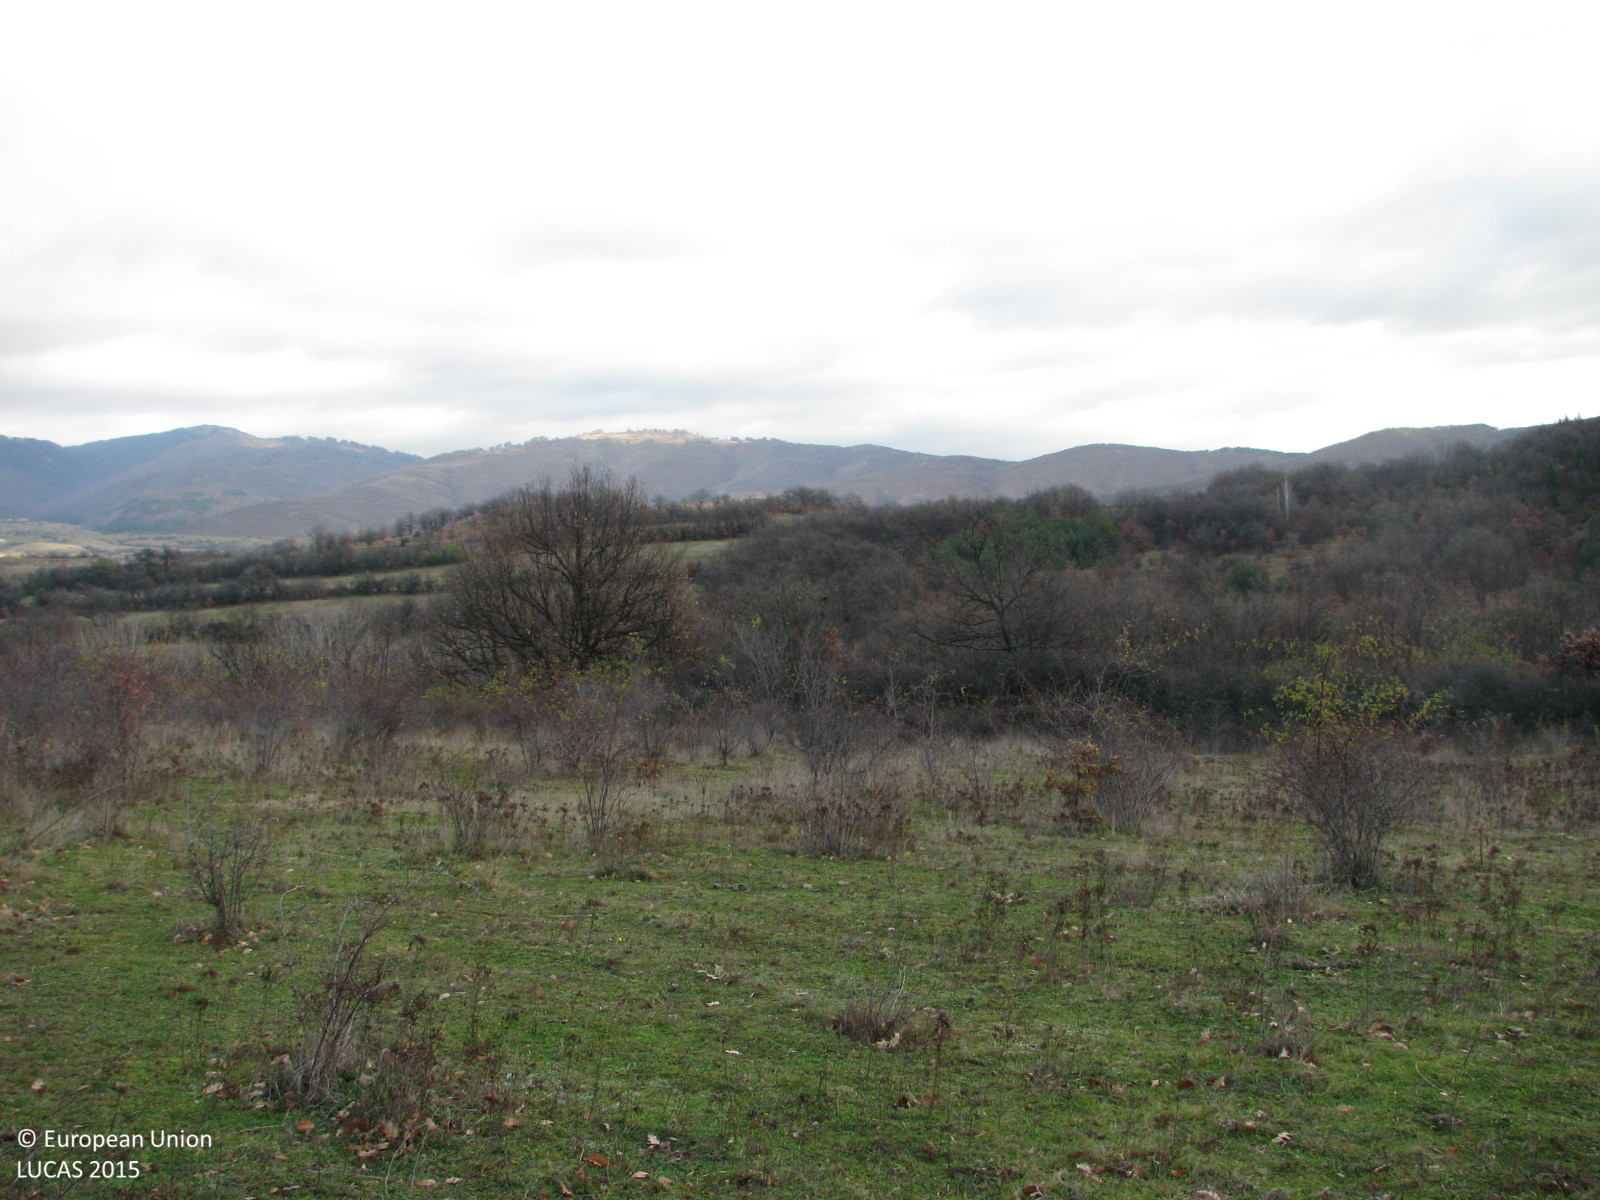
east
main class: Grassland
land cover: Grassland with sparse tree/shrub cover
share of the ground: > 75 %
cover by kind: herbaceous plants 90 %, broadleaved forest trees 5 %, shrubs 5 %
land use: Agriculture (excluding fallow land and kitchen gardens)
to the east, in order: Grassland with sparse tree/shrub cover; Shrubland with sparse tree cover; Grassland without tree/shrub cover; Broadleaved woodland; Grassland with sparse tree/shrub cover; Broadleaved woodland; Rivers and streams; Broadleaved woodland; Grassland with sparse tree/shrub cover
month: December
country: BG
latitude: 42.5402
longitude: 24.2323
